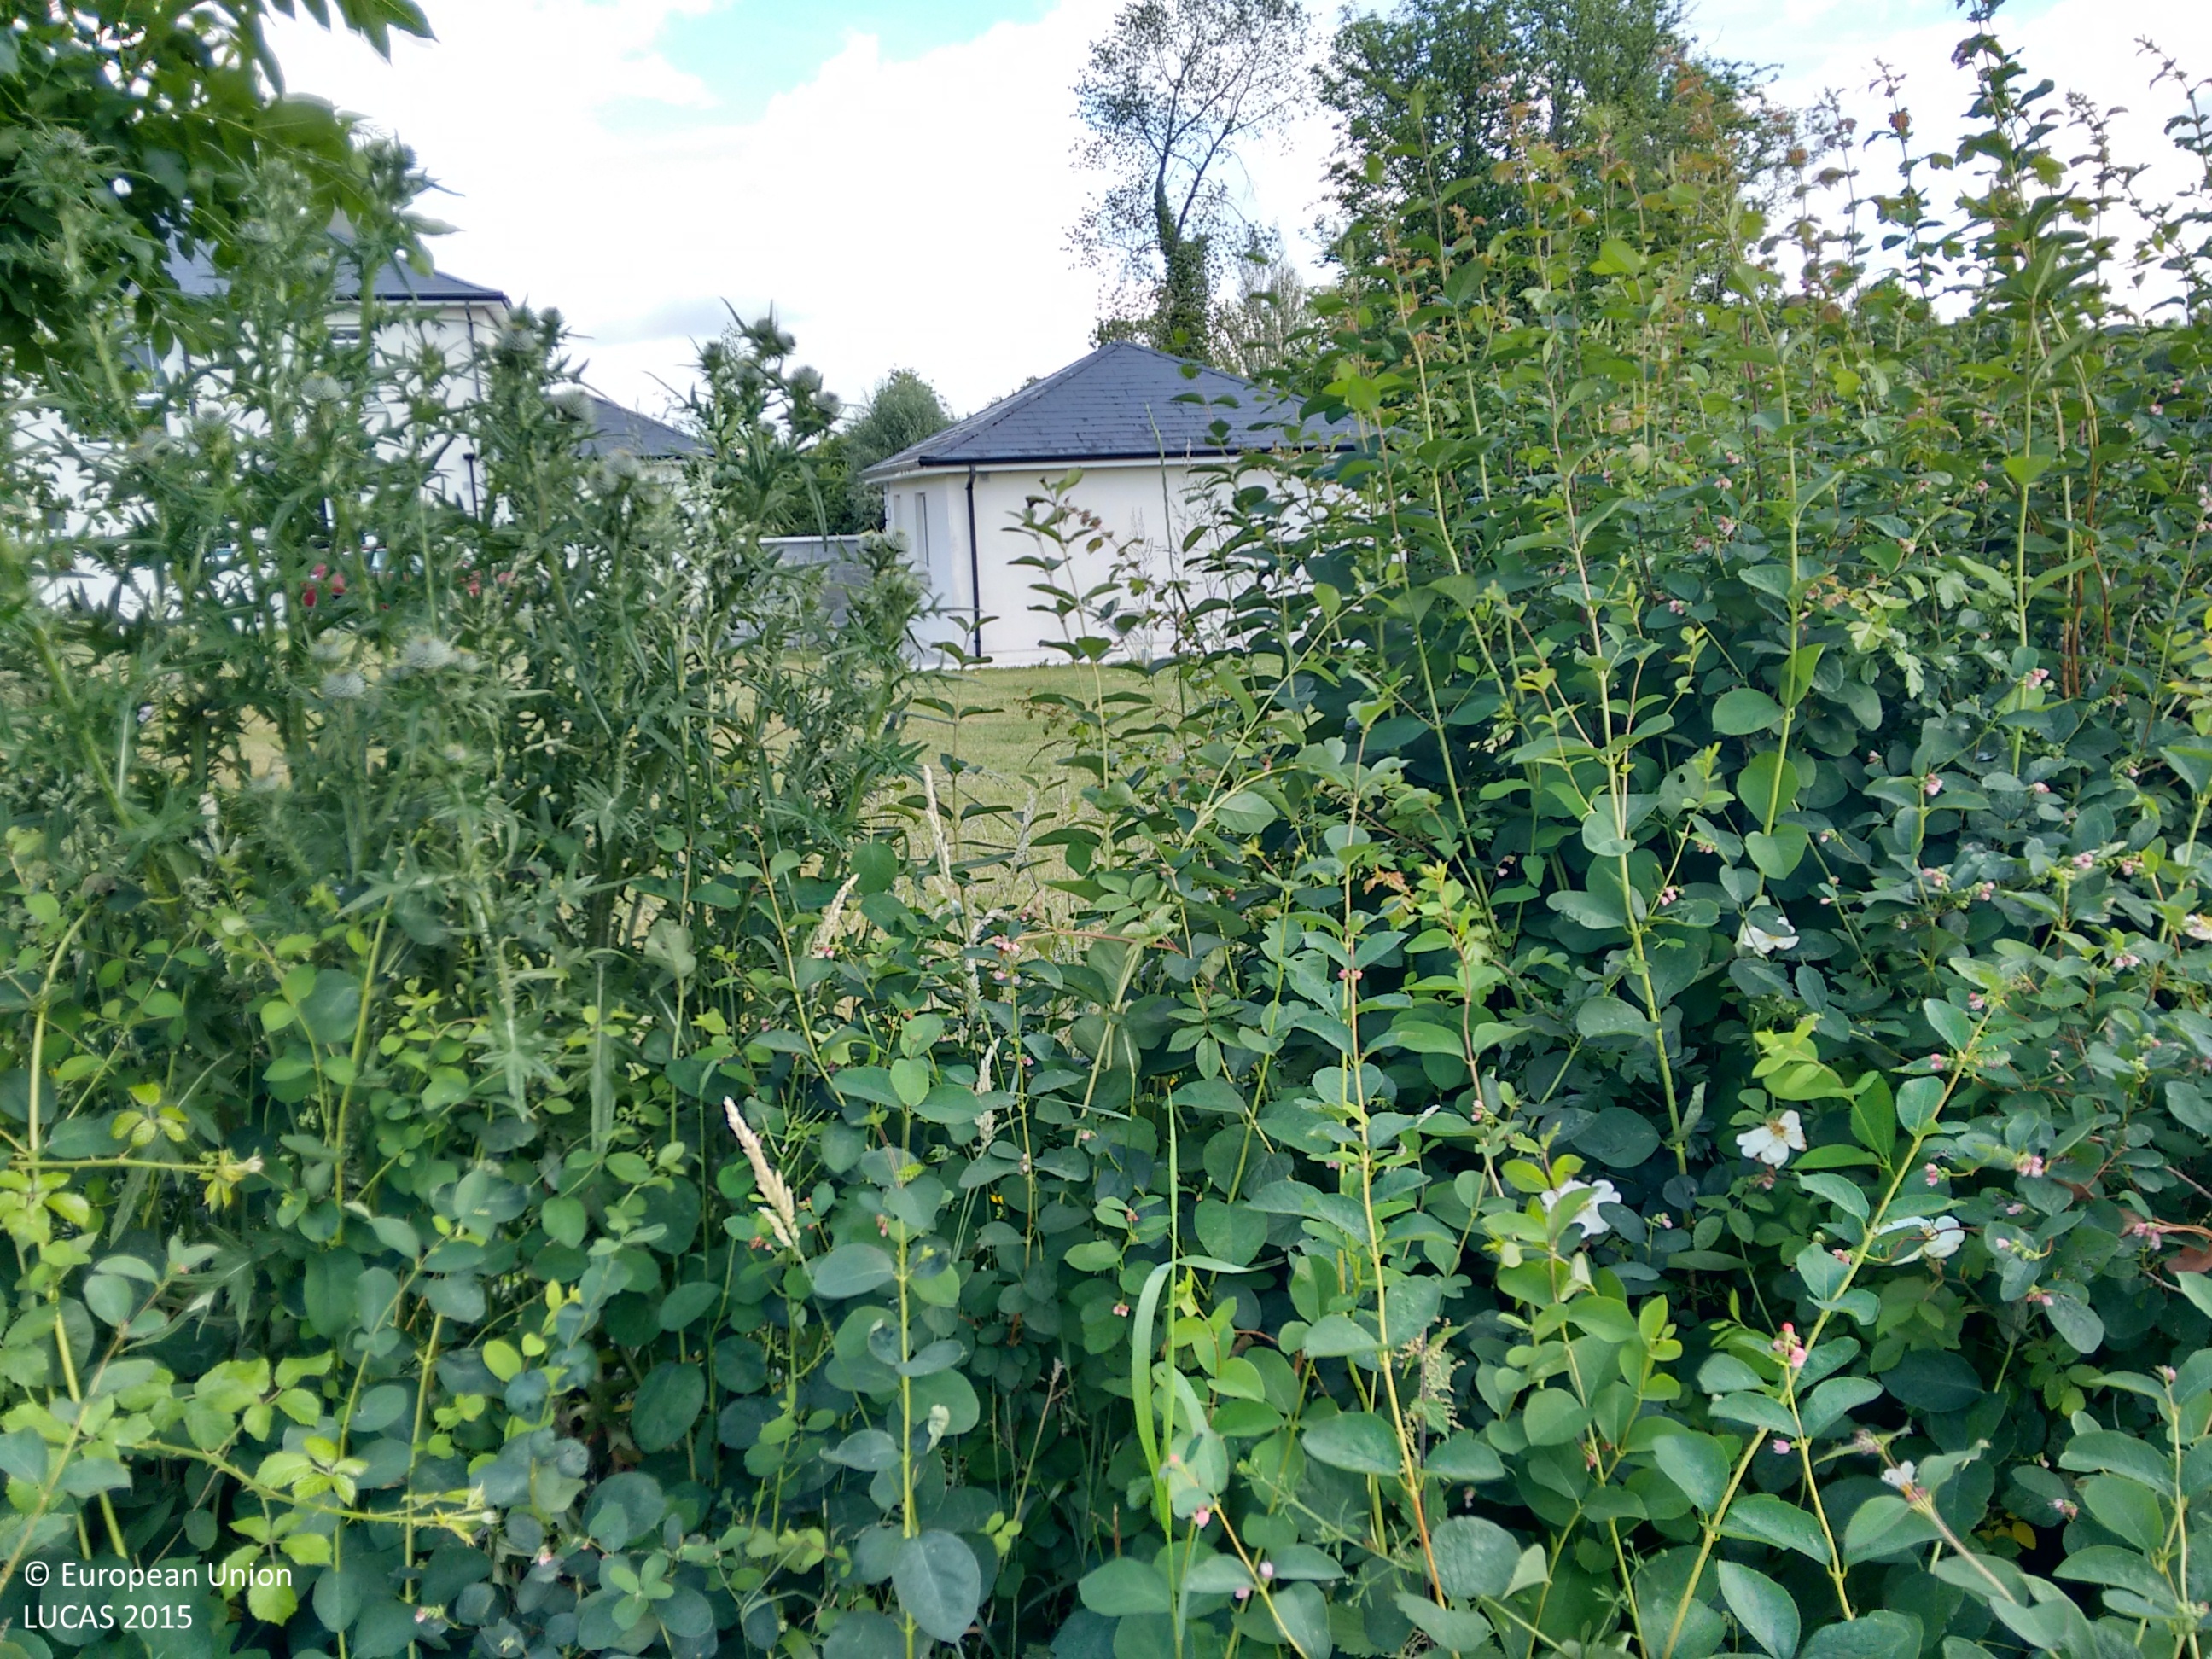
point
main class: Grassland
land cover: Grassland with sparse tree/shrub cover
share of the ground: > 75 %
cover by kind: herbaceous plants 95 %, broadleaved forest trees 5 %
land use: Residential
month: July
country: IE
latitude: 52.5218
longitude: -7.5974
